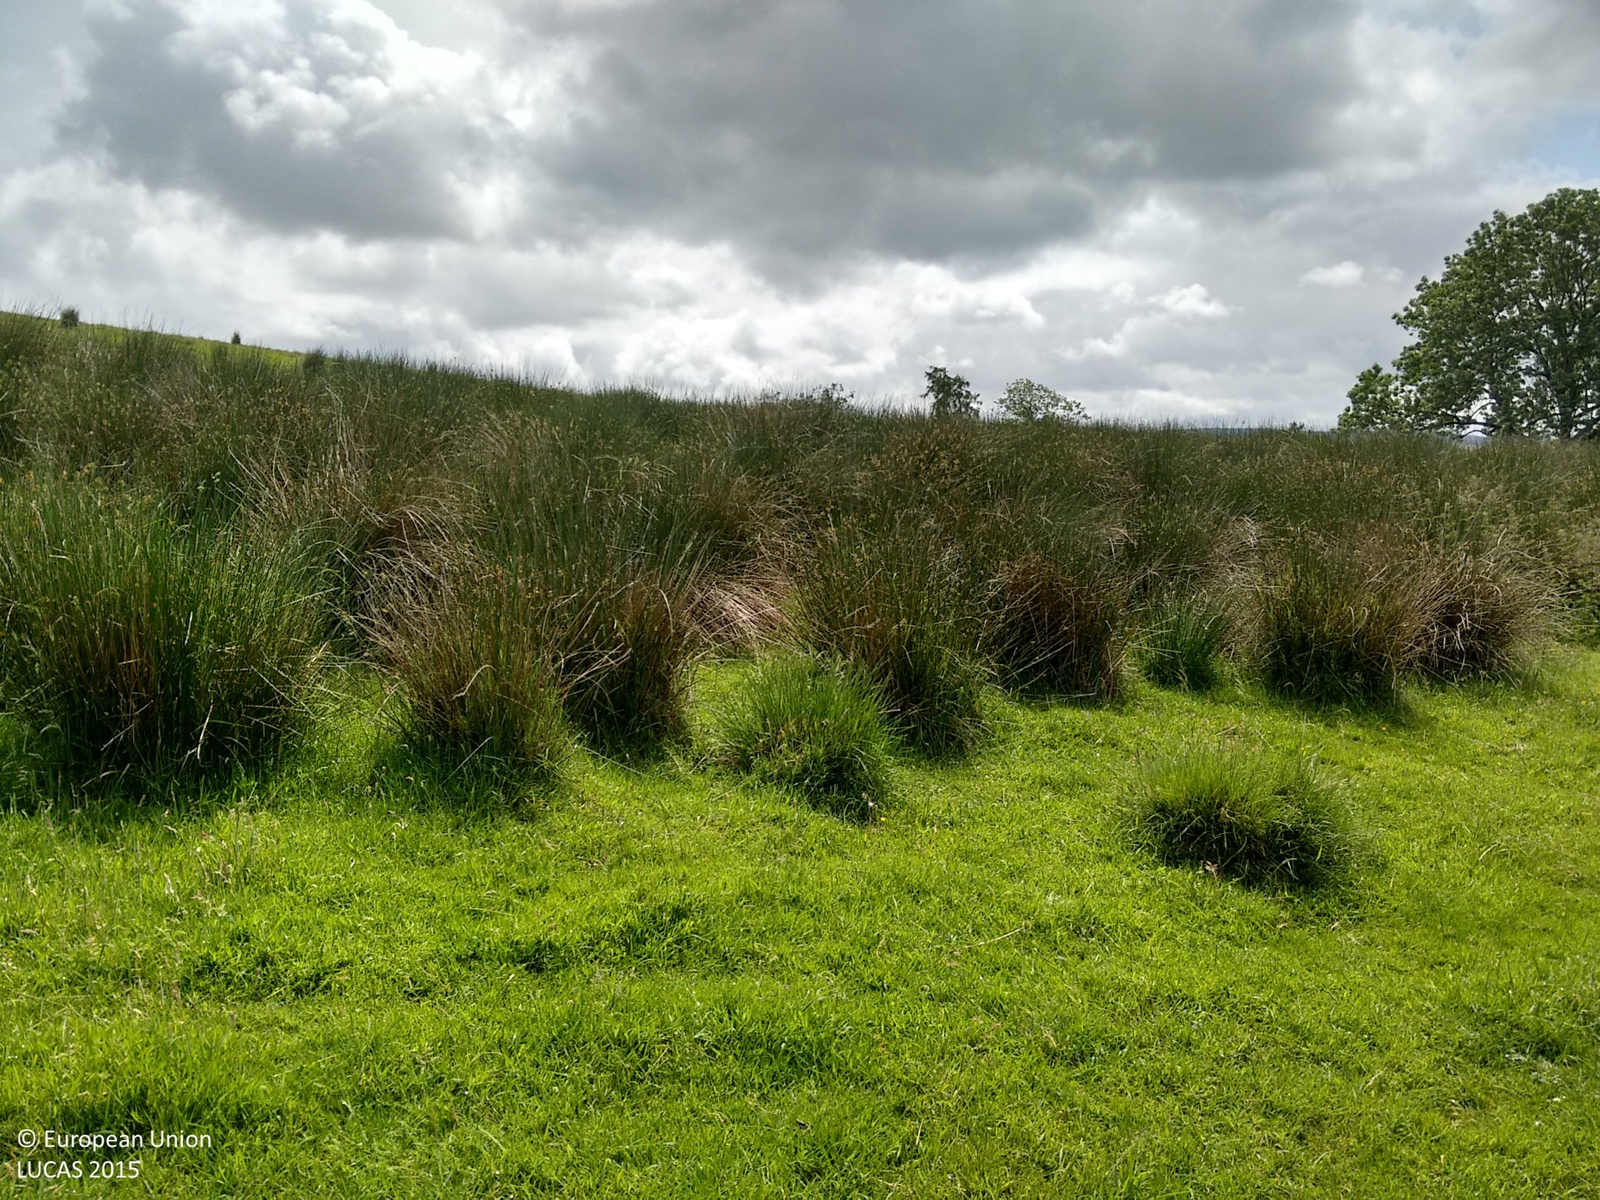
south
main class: Grassland
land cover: Grassland without tree/shrub cover
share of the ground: > 75 %
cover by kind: herbaceous plants 100 %
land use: Agriculture (excluding fallow land and kitchen gardens)
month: July
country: GB
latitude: 57.3691
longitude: -2.7782
